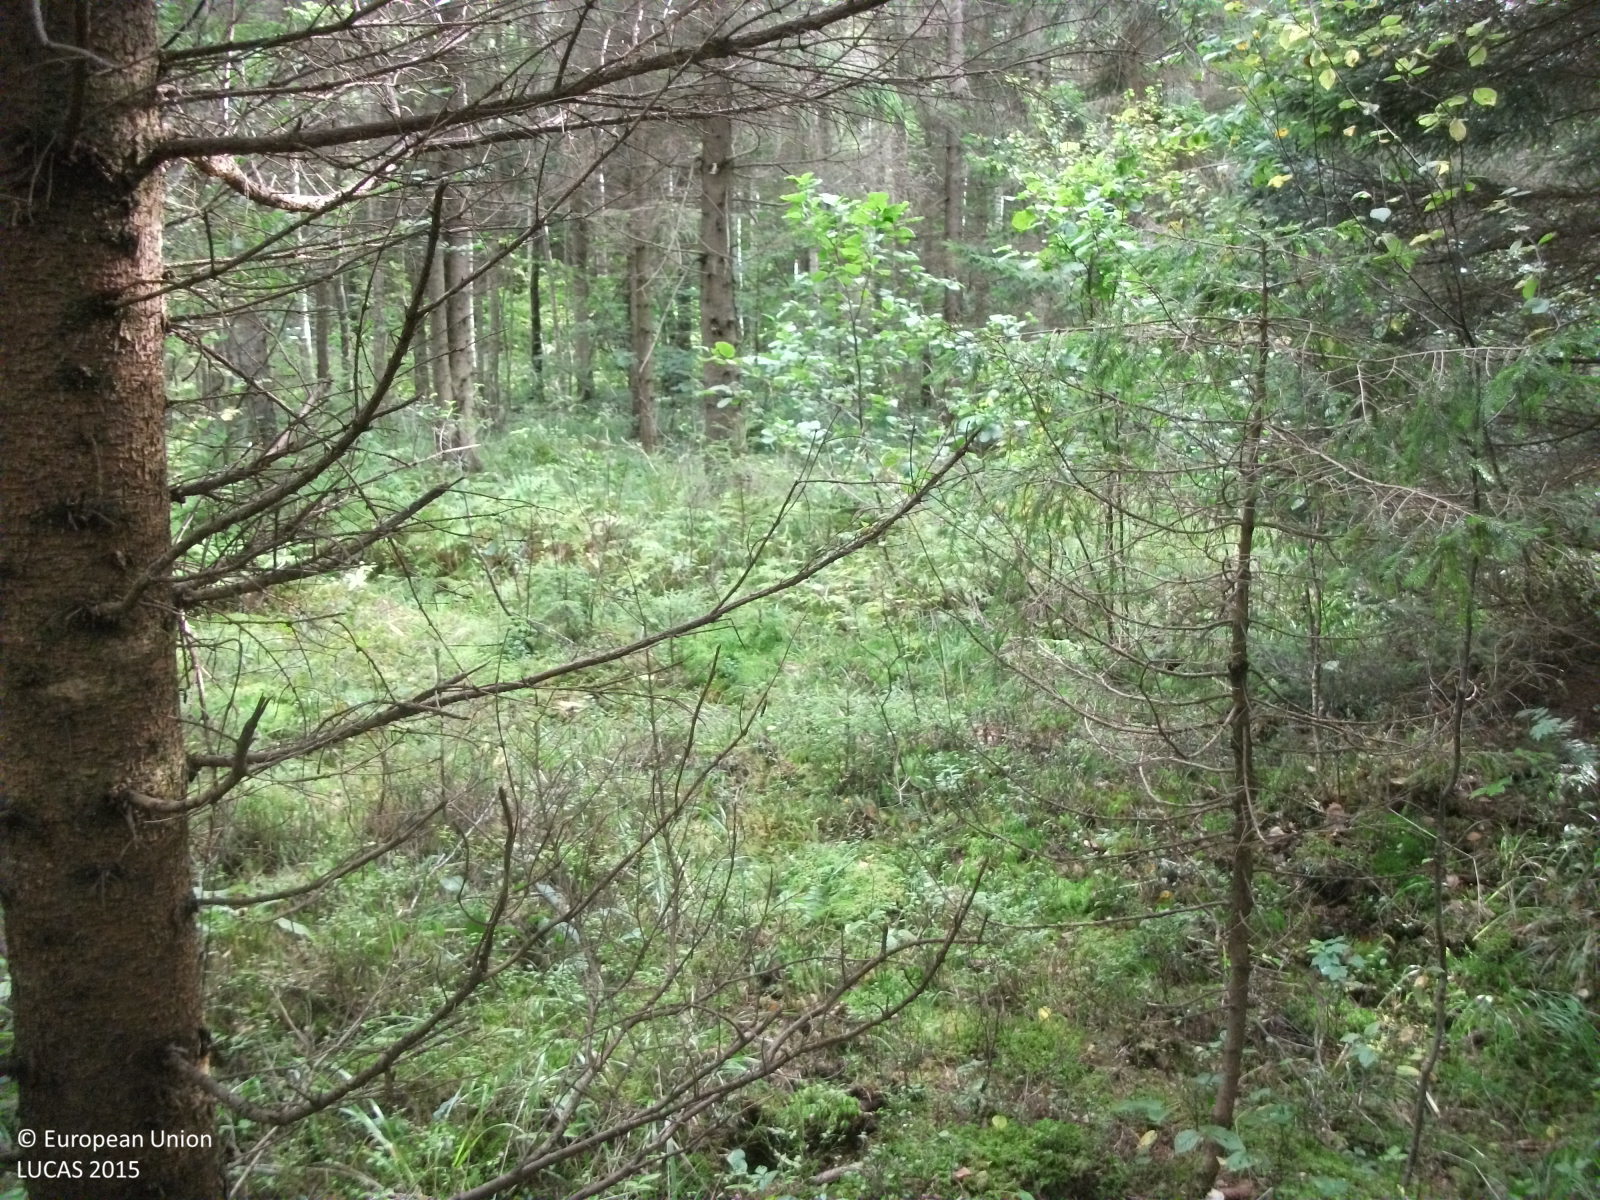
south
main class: Woodland
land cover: Spruce dominated coniferous woodland
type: hemiboreal forest and nemoral coniferous forest and mixed broadleaved-coniferous forest
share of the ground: > 75 %
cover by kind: coniferous forest trees 80 %, lichens and mosses 10 %, shrubs 5 %, herbaceous plants 5 %
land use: Forestry
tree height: > 5 m
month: September
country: LV
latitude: 57.5823
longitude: 24.4221
